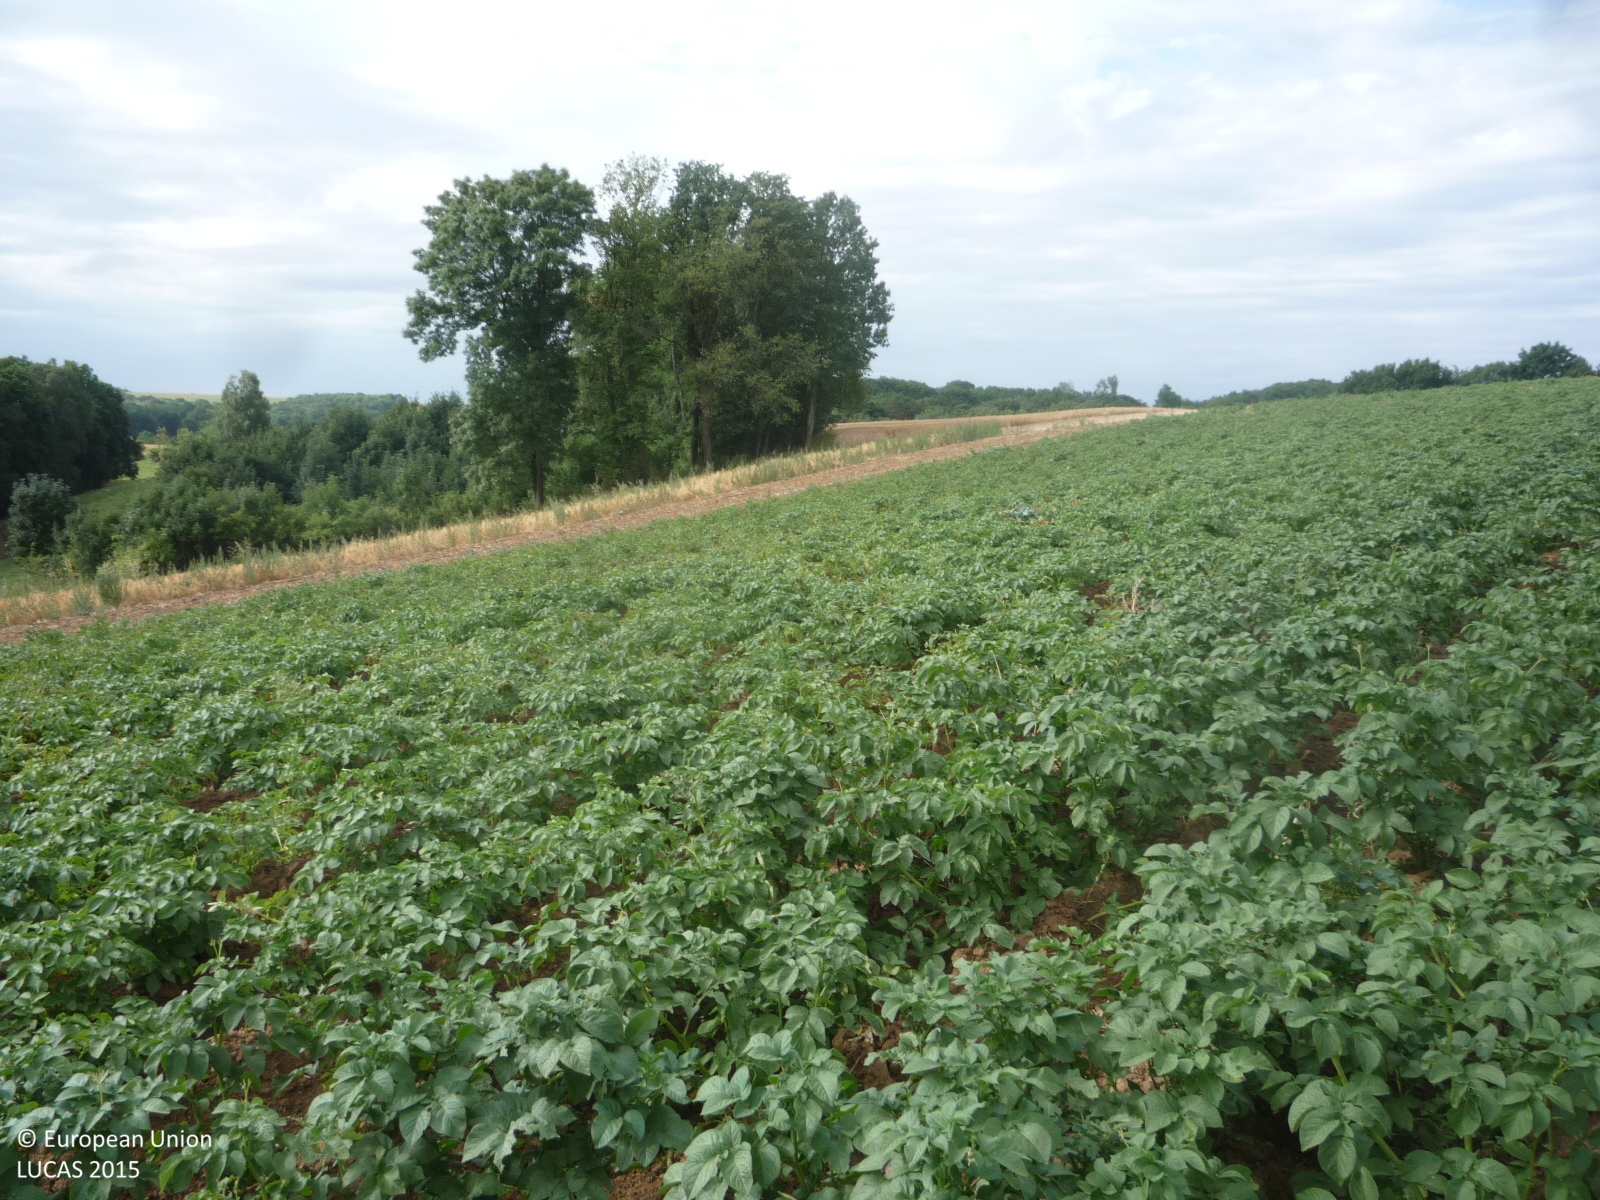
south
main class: Cropland
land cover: Potatoes
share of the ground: > 75 %
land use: Agriculture (excluding fallow land and kitchen gardens)
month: July
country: CZ
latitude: 50.4069
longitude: 15.2236
